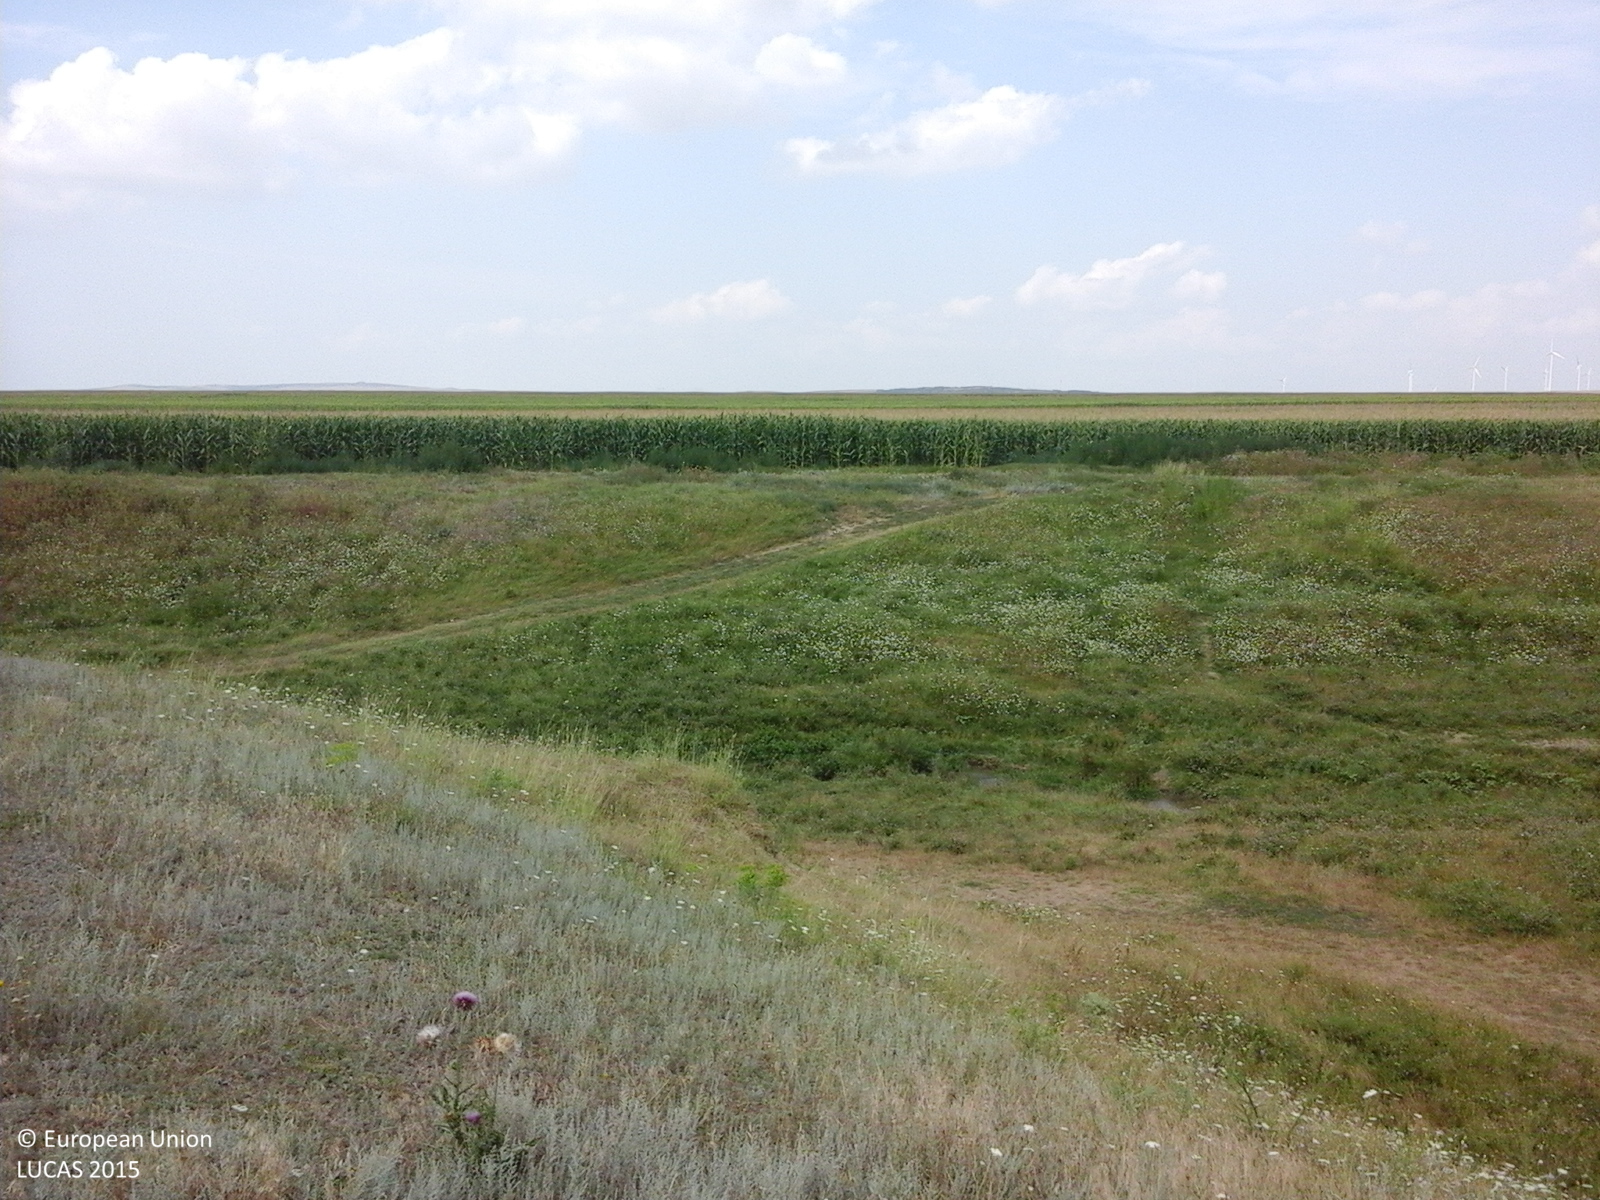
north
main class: Grassland
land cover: Spontaneously vegetated surfaces
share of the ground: > 75 %
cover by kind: herbaceous plants 100 %
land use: Agriculture (excluding fallow land and kitchen gardens)
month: July
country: RO
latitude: 44.8685
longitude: 28.2831
